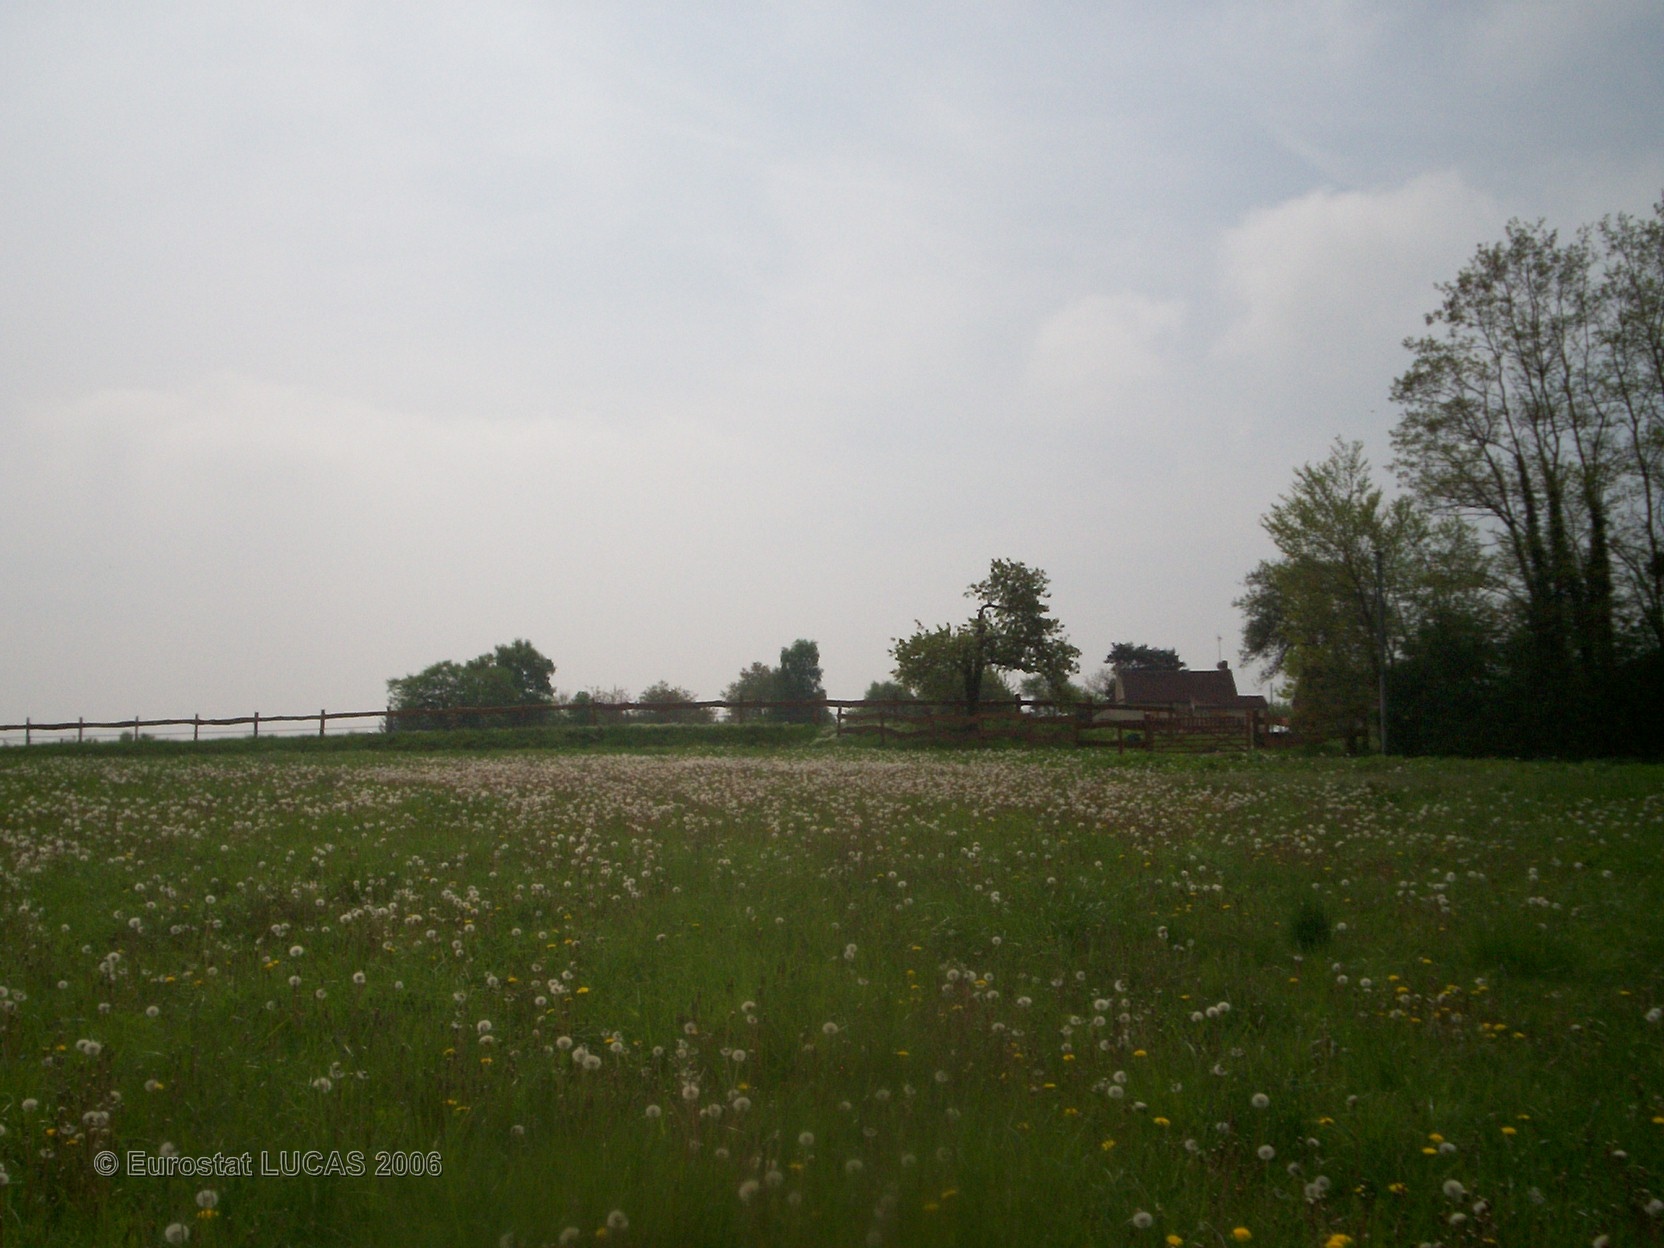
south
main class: Grassland
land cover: Grassland without tree/shrub cover
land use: Fallow land
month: May
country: FR
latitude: 47.9282
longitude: 2.9932
